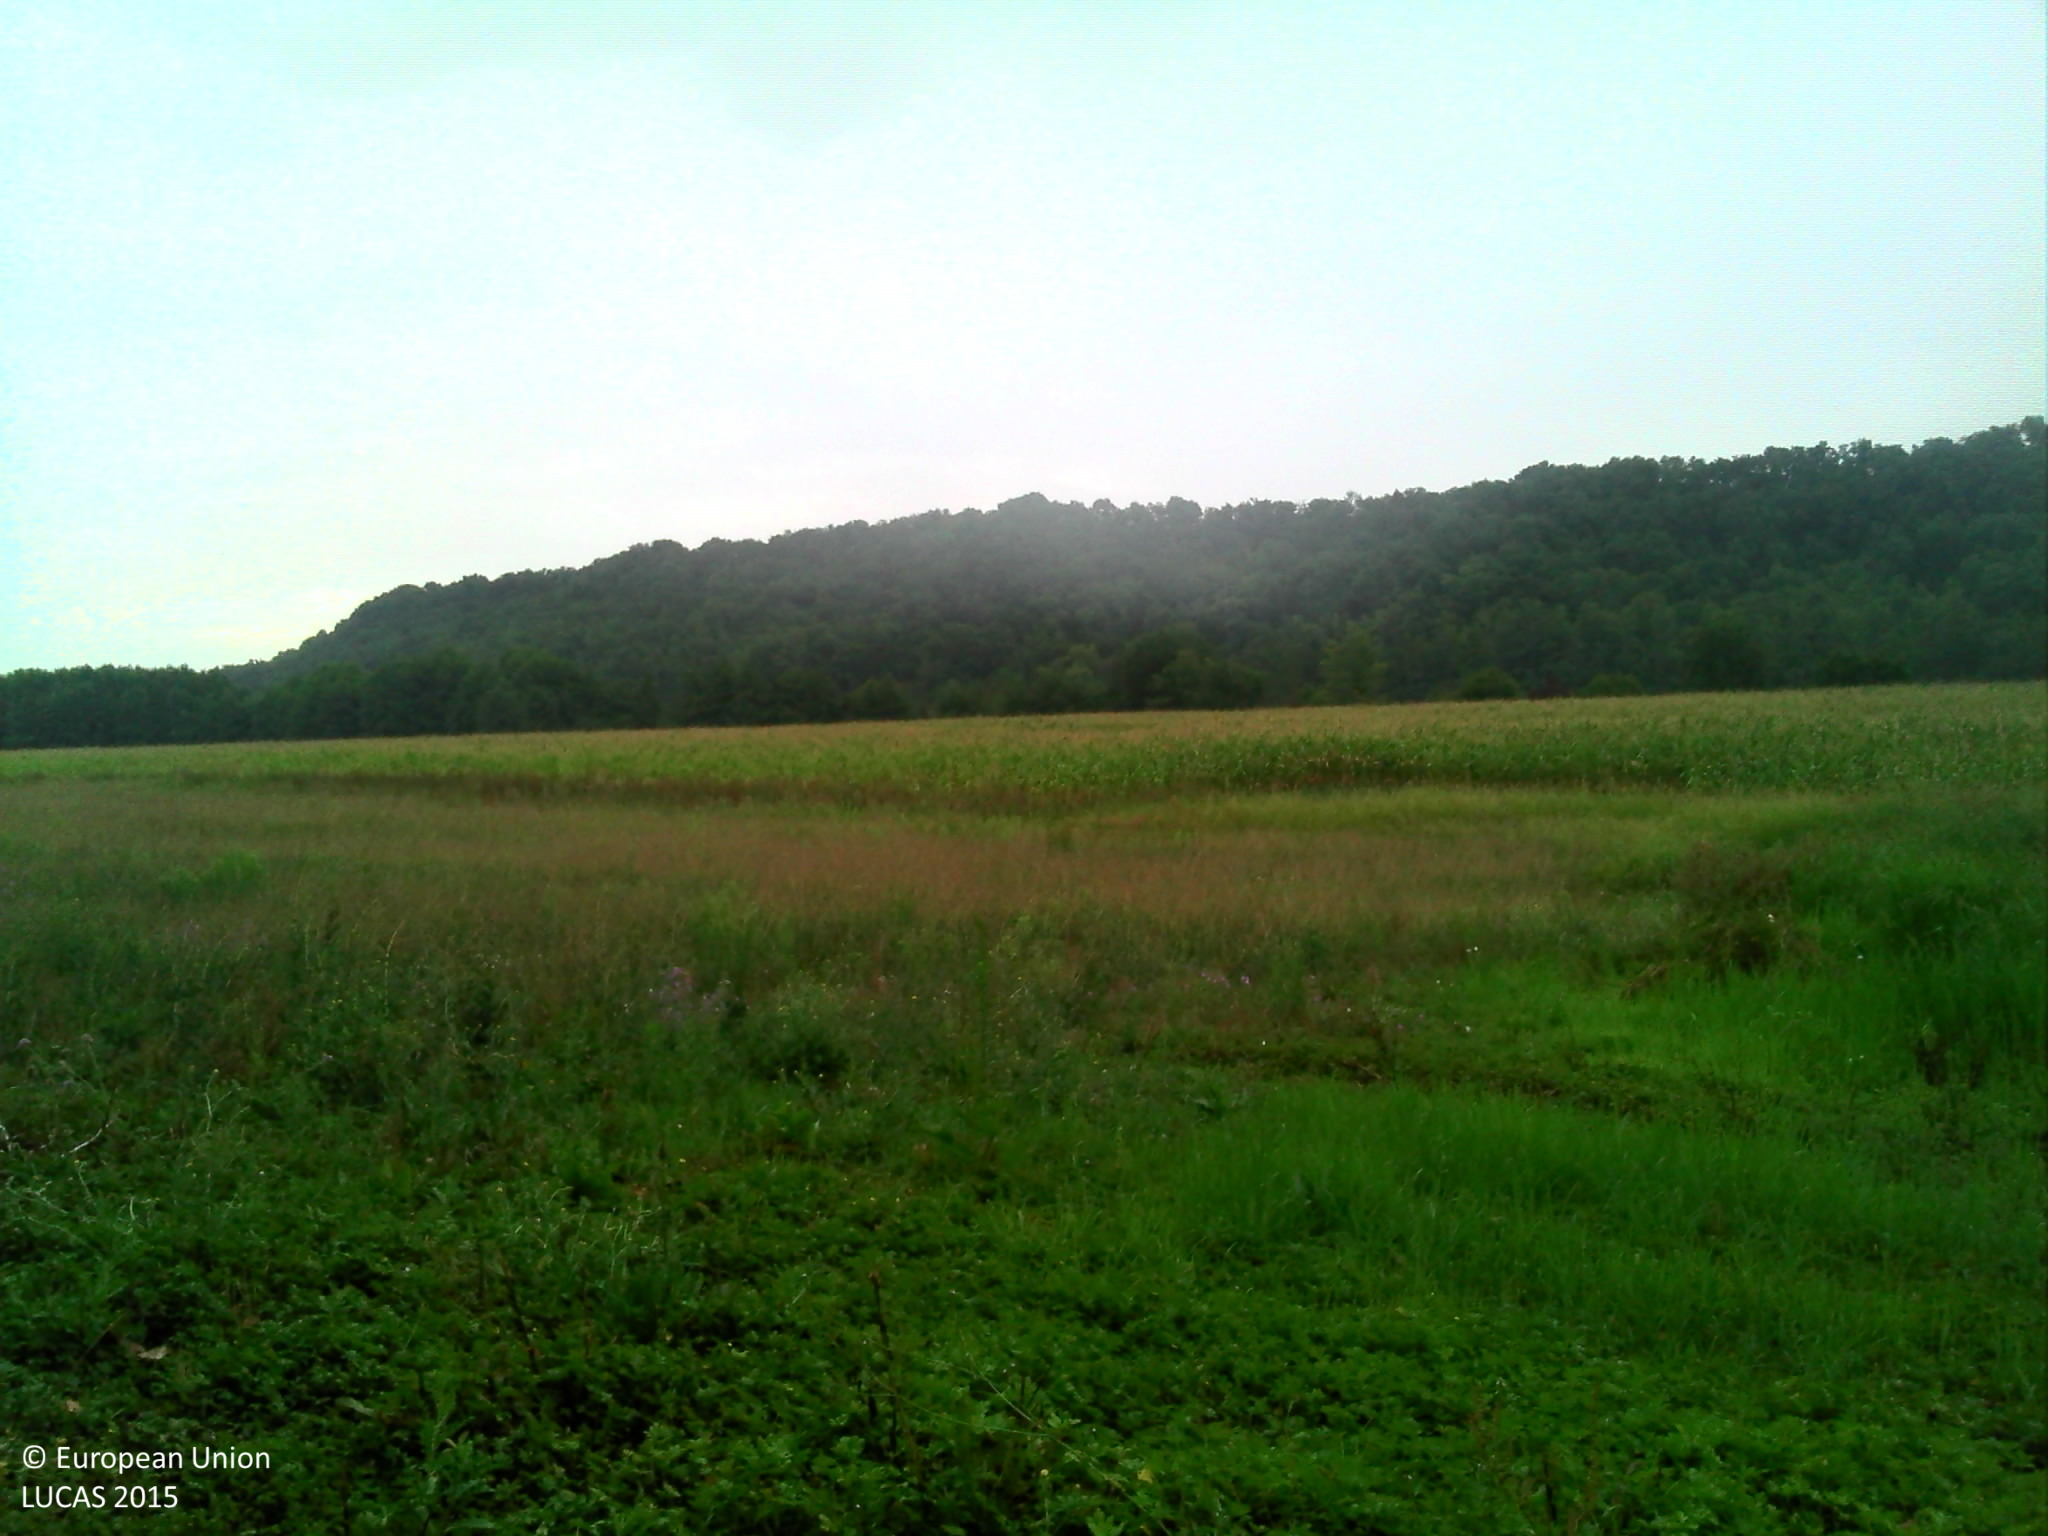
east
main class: Woodland
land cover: Broadleaved woodland
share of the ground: > 75 %
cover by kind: broadleaved forest trees 80 %, shrubs 20 %
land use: Semi-natural and natural areas not in use
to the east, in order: Spontaneously vegetated surfaces; Maize; Grassland without tree/shrub cover
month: July
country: FR
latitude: 43.2660
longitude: 1.1698
